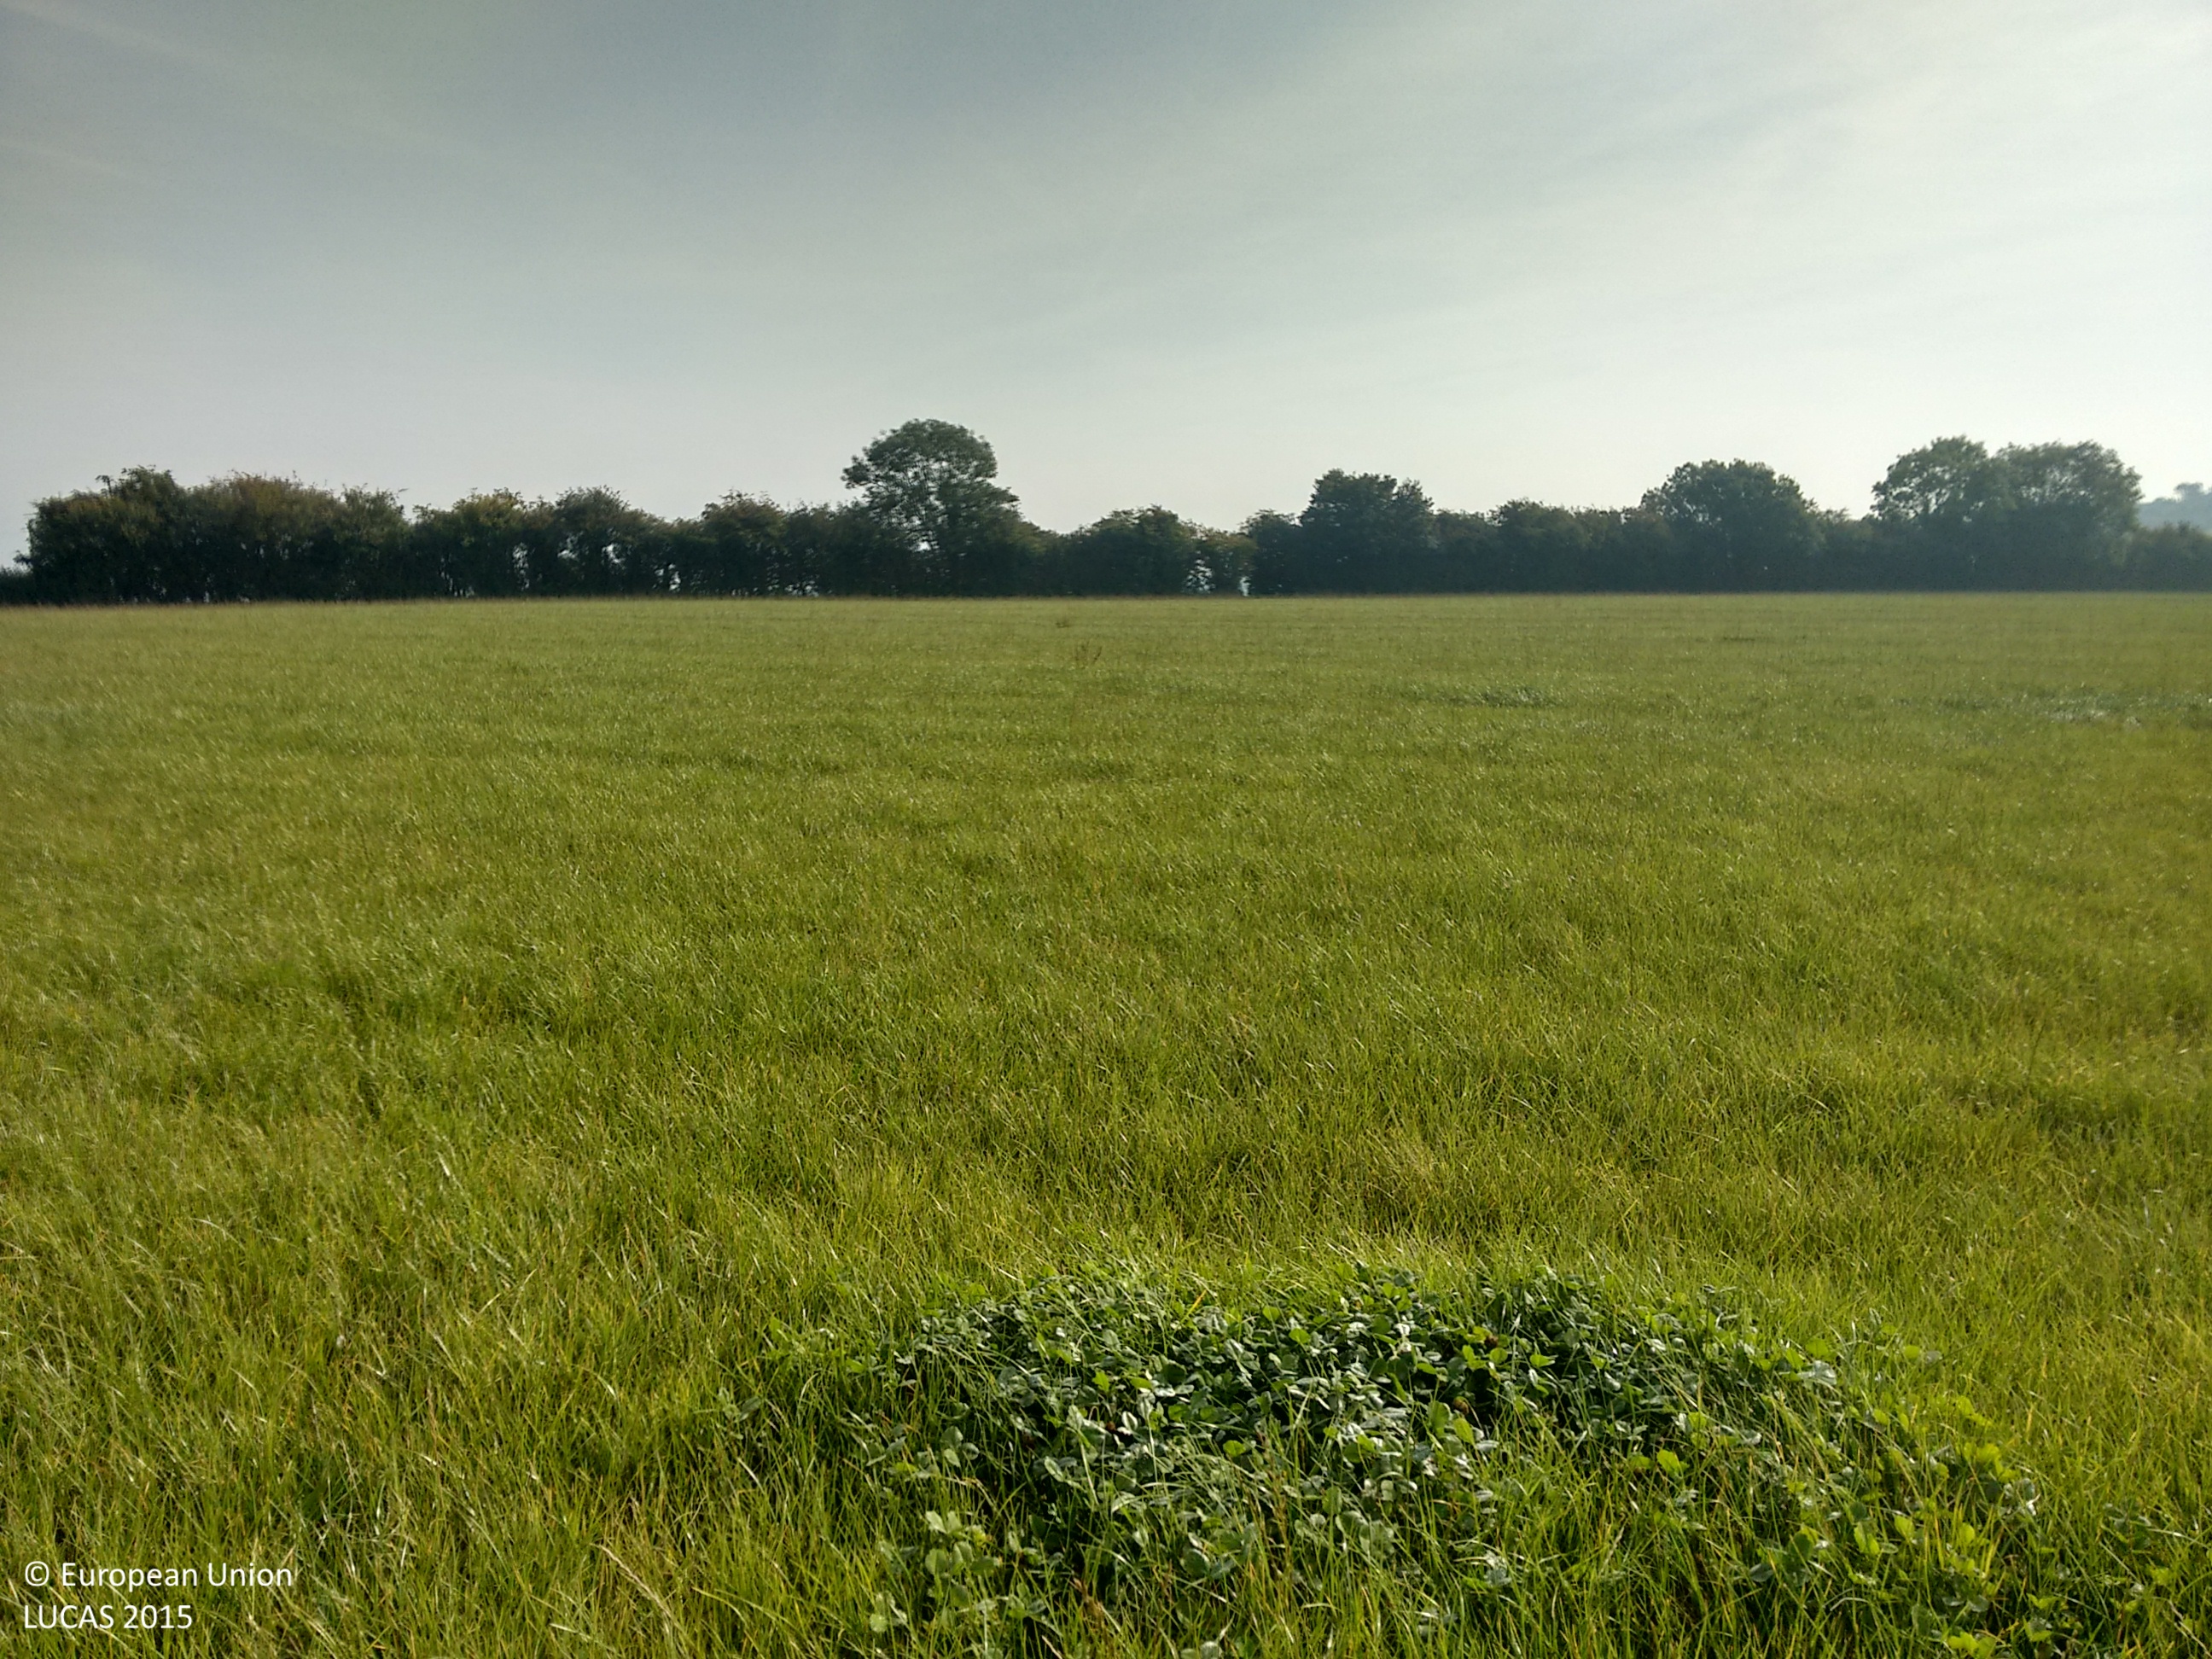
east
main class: Grassland
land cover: Grassland without tree/shrub cover
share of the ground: > 75 %
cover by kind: herbaceous plants 100 %
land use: Agriculture (excluding fallow land and kitchen gardens)
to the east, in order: Grassland without tree/shrub cover; Managed hedges; Grass margins; Tracks; Grass margins; Managed hedges; Fences; Grassland without tree/shrub cover; Electric lines; Grassland without tree/shrub cover
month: September
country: GB
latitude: 52.8405
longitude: -2.3410
